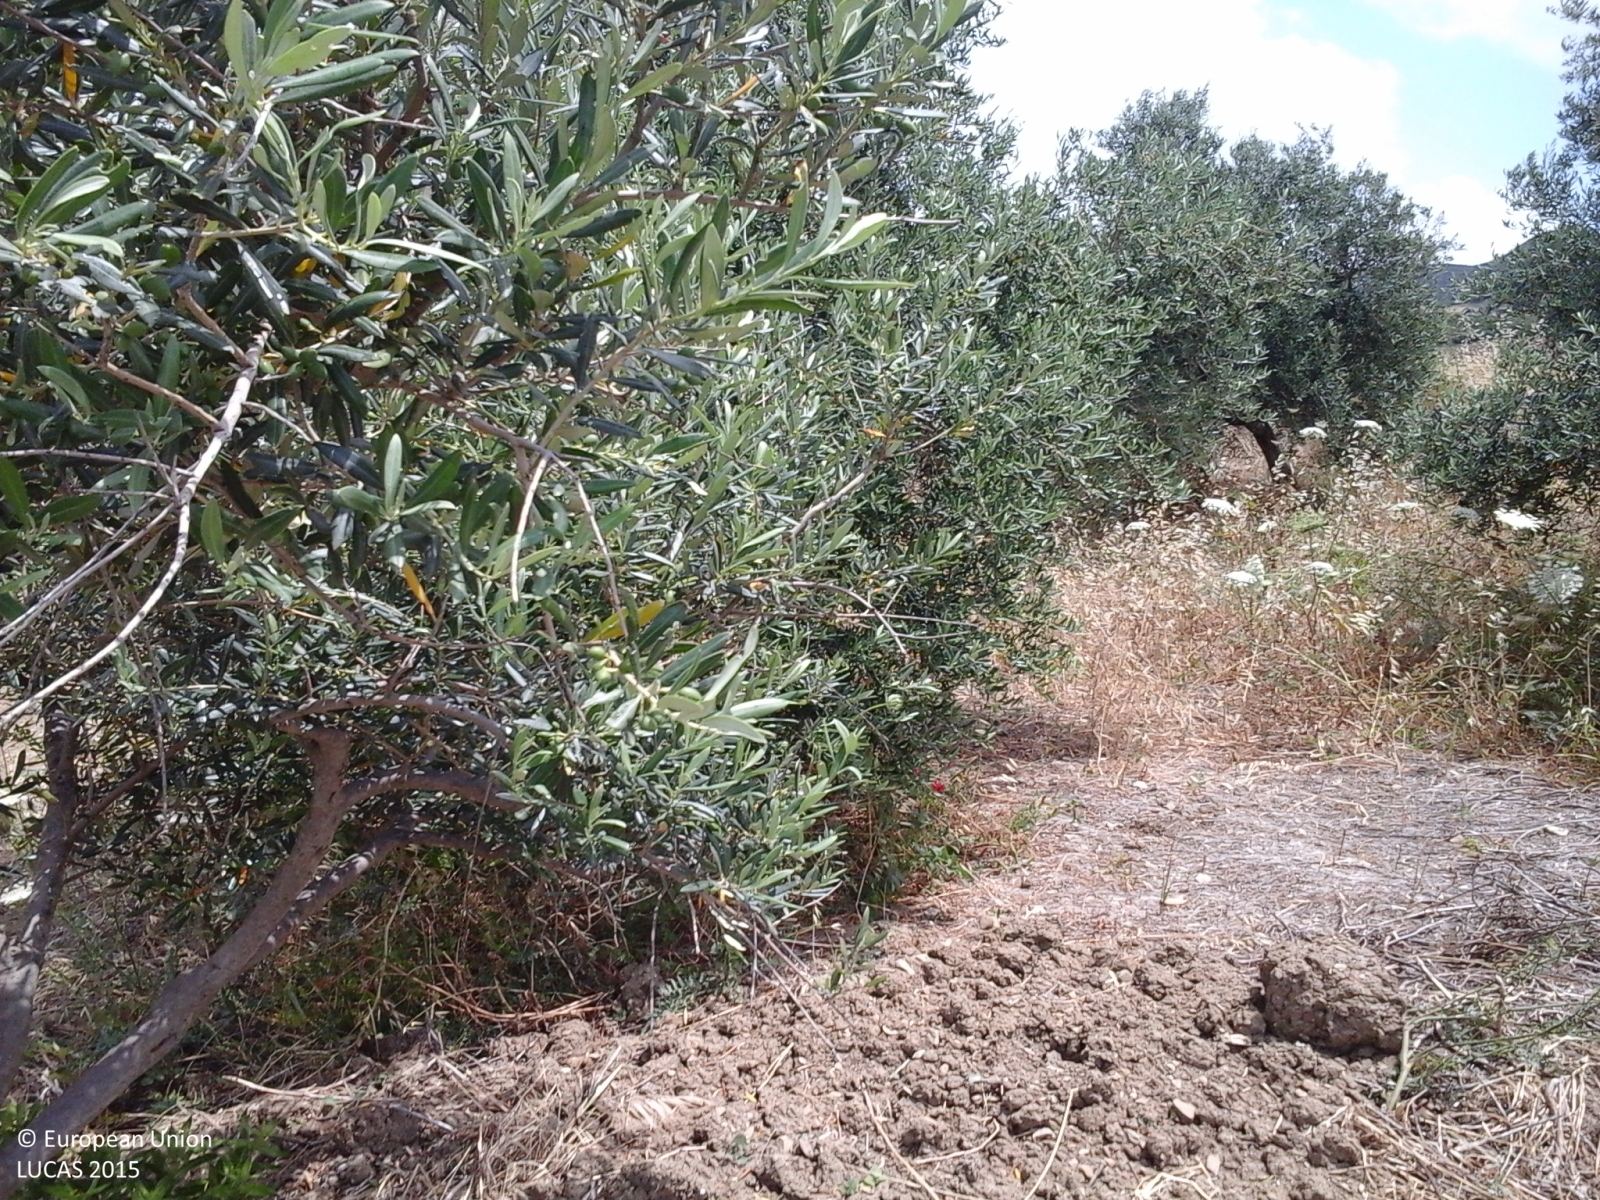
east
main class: Cropland
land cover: Olive groves
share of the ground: 25 - 50 %
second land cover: Spontaneously vegetated surfaces
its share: > 75 %
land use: Agriculture (excluding fallow land and kitchen gardens)
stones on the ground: < 10 %
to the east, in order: Olive groves; Spontaneously vegetated surfaces; Fences; Arable land (only in case pi); Fences; Permanent crops (only in case pi); Tracks; Grassland with sparse tree/shrub cover; Grassland without tree/shrub cover; Tracks; Spontaneously vegetated surfaces; Olive groves; Fences; Paved roads, cycling and walking lanes; Managed hedges; Electric lines; Spontaneously vegetated surfaces
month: June
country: IT
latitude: 37.8894
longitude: 13.8049
